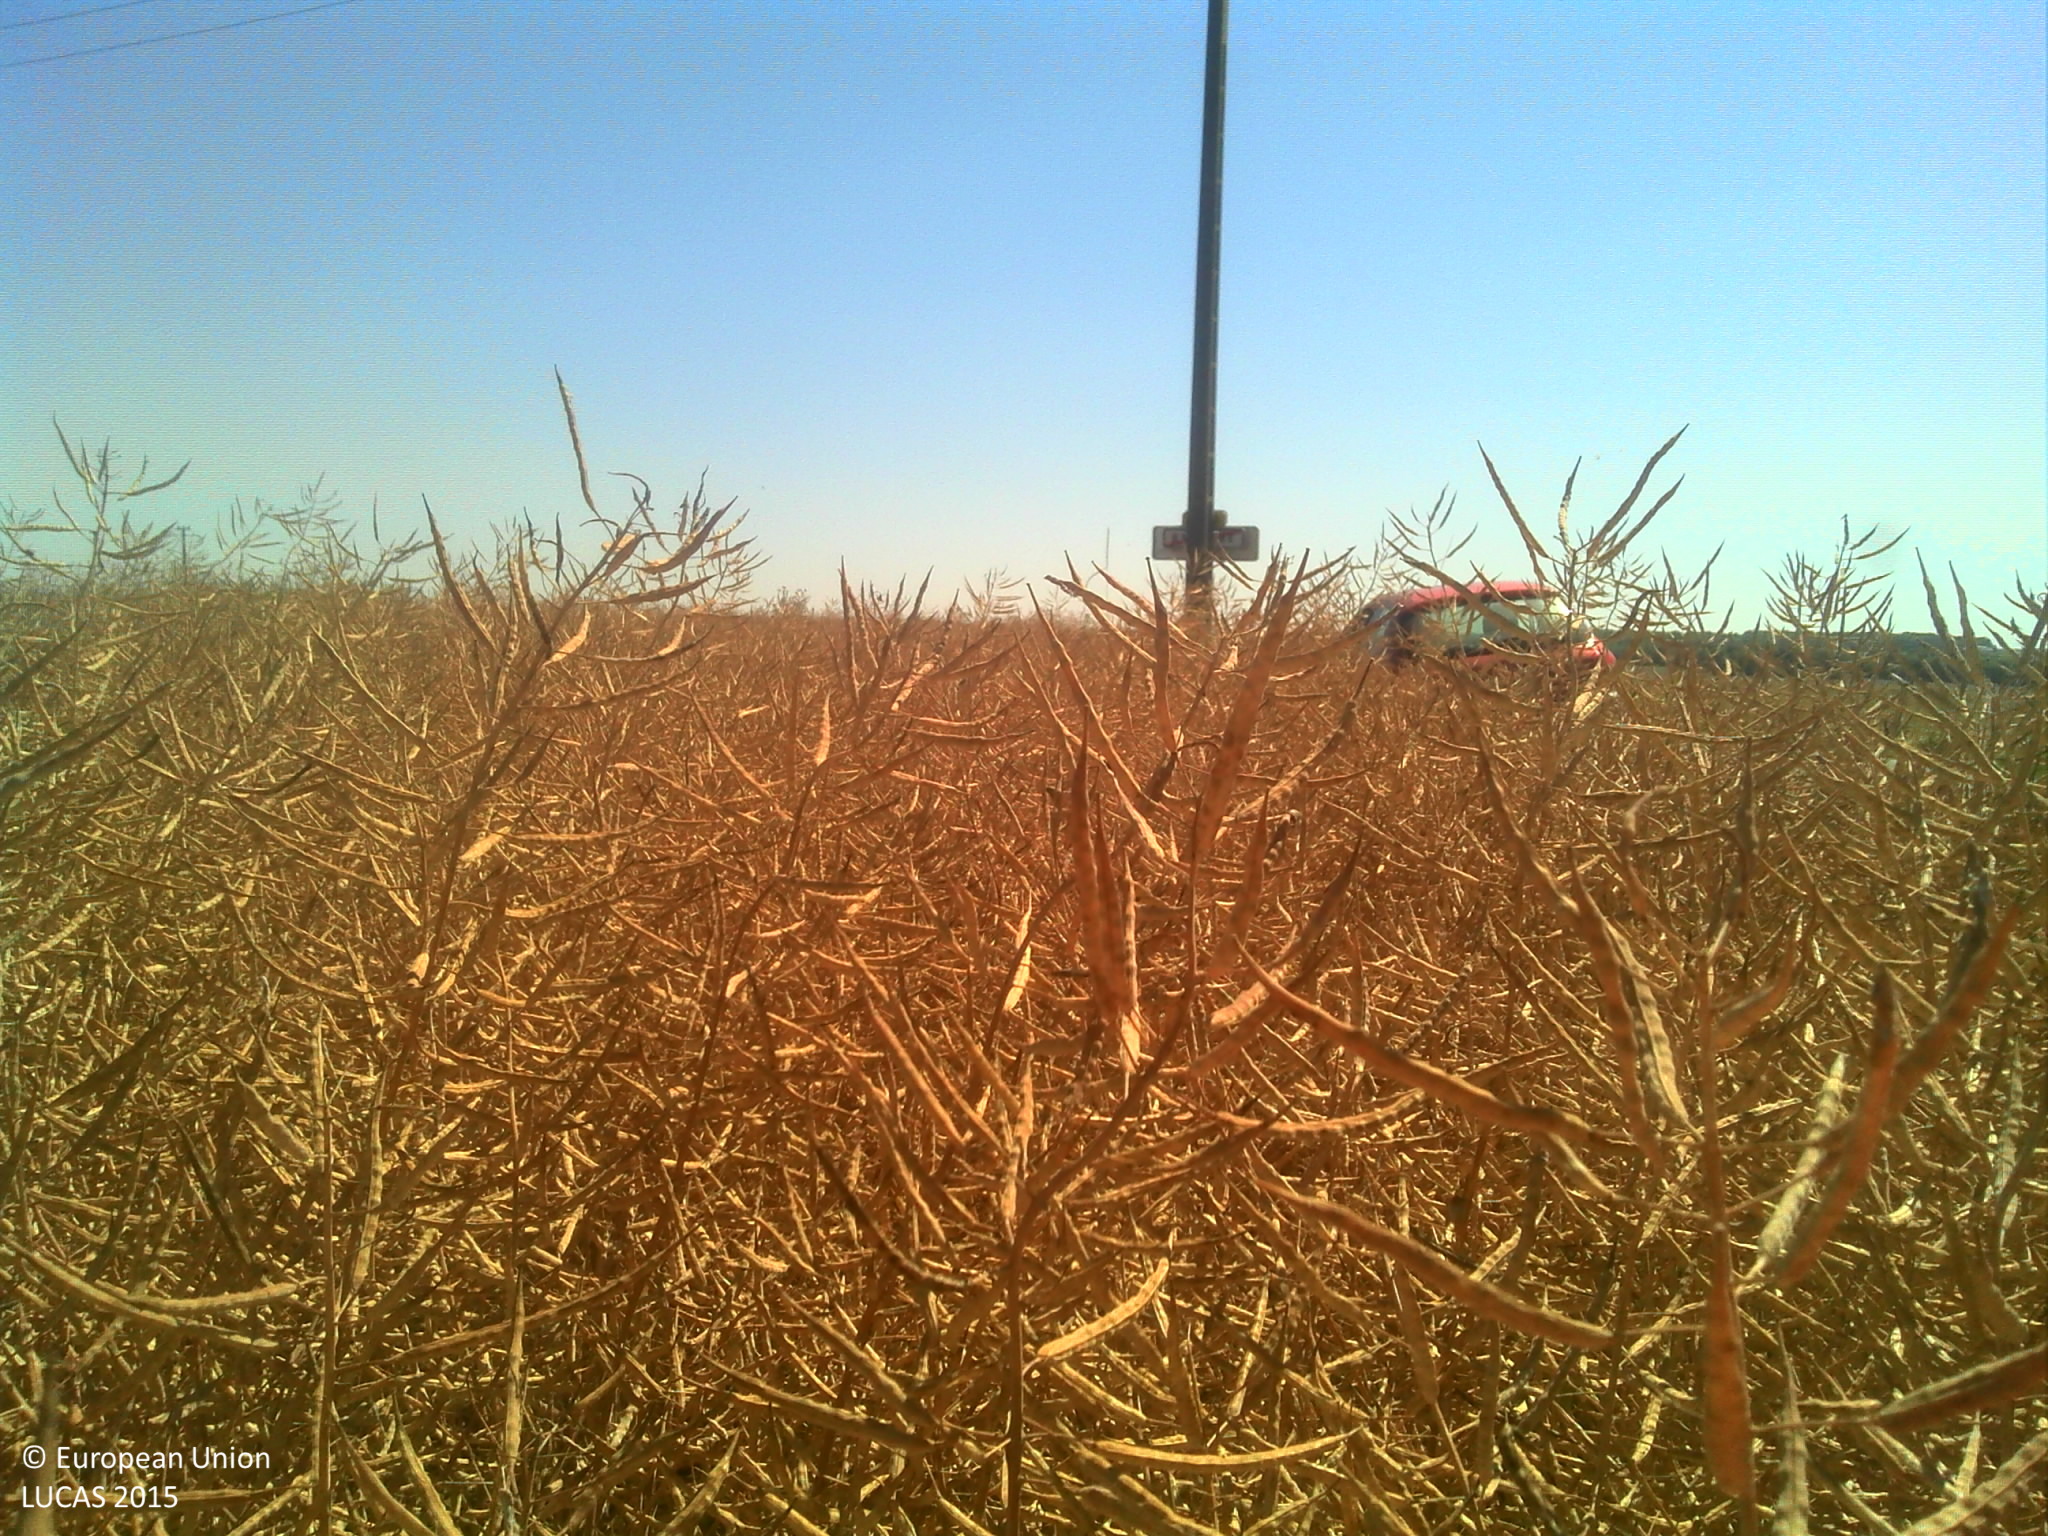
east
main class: Cropland
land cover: Rape and turnip rape
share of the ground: > 75 %
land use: Agriculture (excluding fallow land and kitchen gardens)
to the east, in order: Rape and turnip rape; Electric lines; Grass margins; Paved roads, cycling and walking lanes; Grass margins; Rape and turnip rape
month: July
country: FR
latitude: 48.0087
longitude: 1.3372
